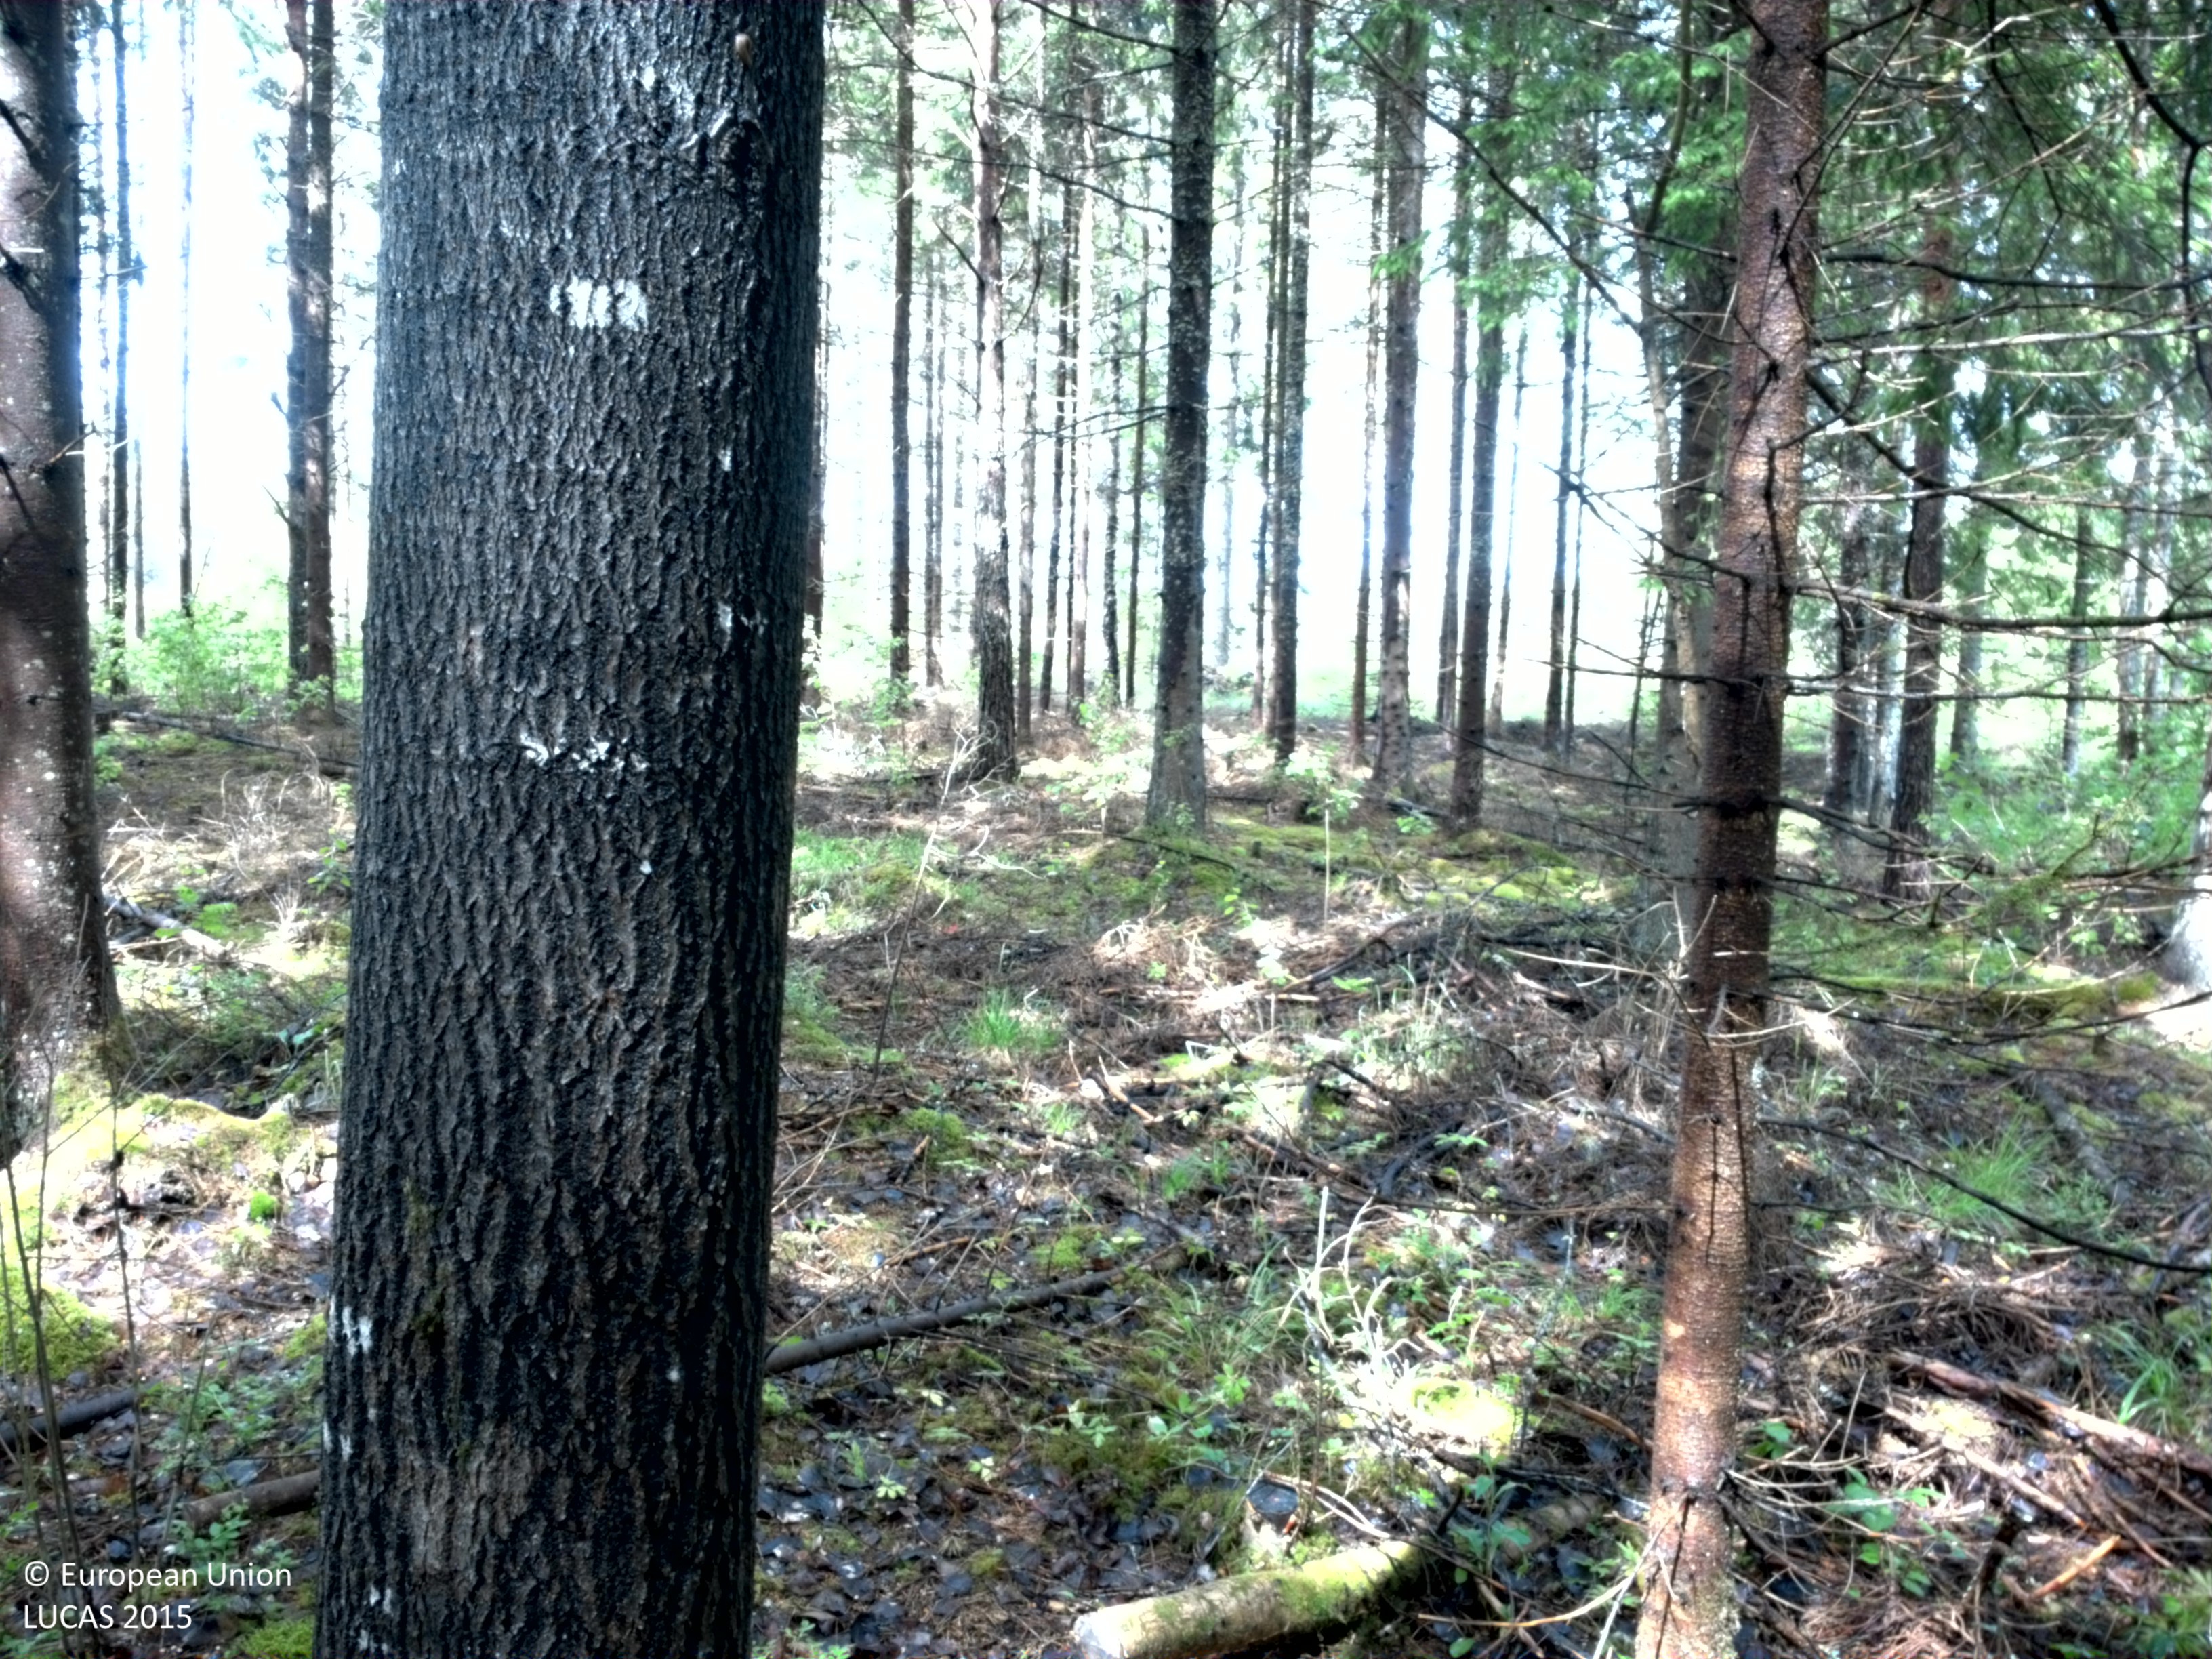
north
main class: Woodland
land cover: Spruce dominated coniferous woodland
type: boreal forest
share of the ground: > 75 %
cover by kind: coniferous forest trees 85 %, broadleaved forest trees 5 %, herbaceous plants 5 %, lichens and mosses 5 %
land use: Forestry
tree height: > 5 m
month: June
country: SE
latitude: 59.8581
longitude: 17.0805
